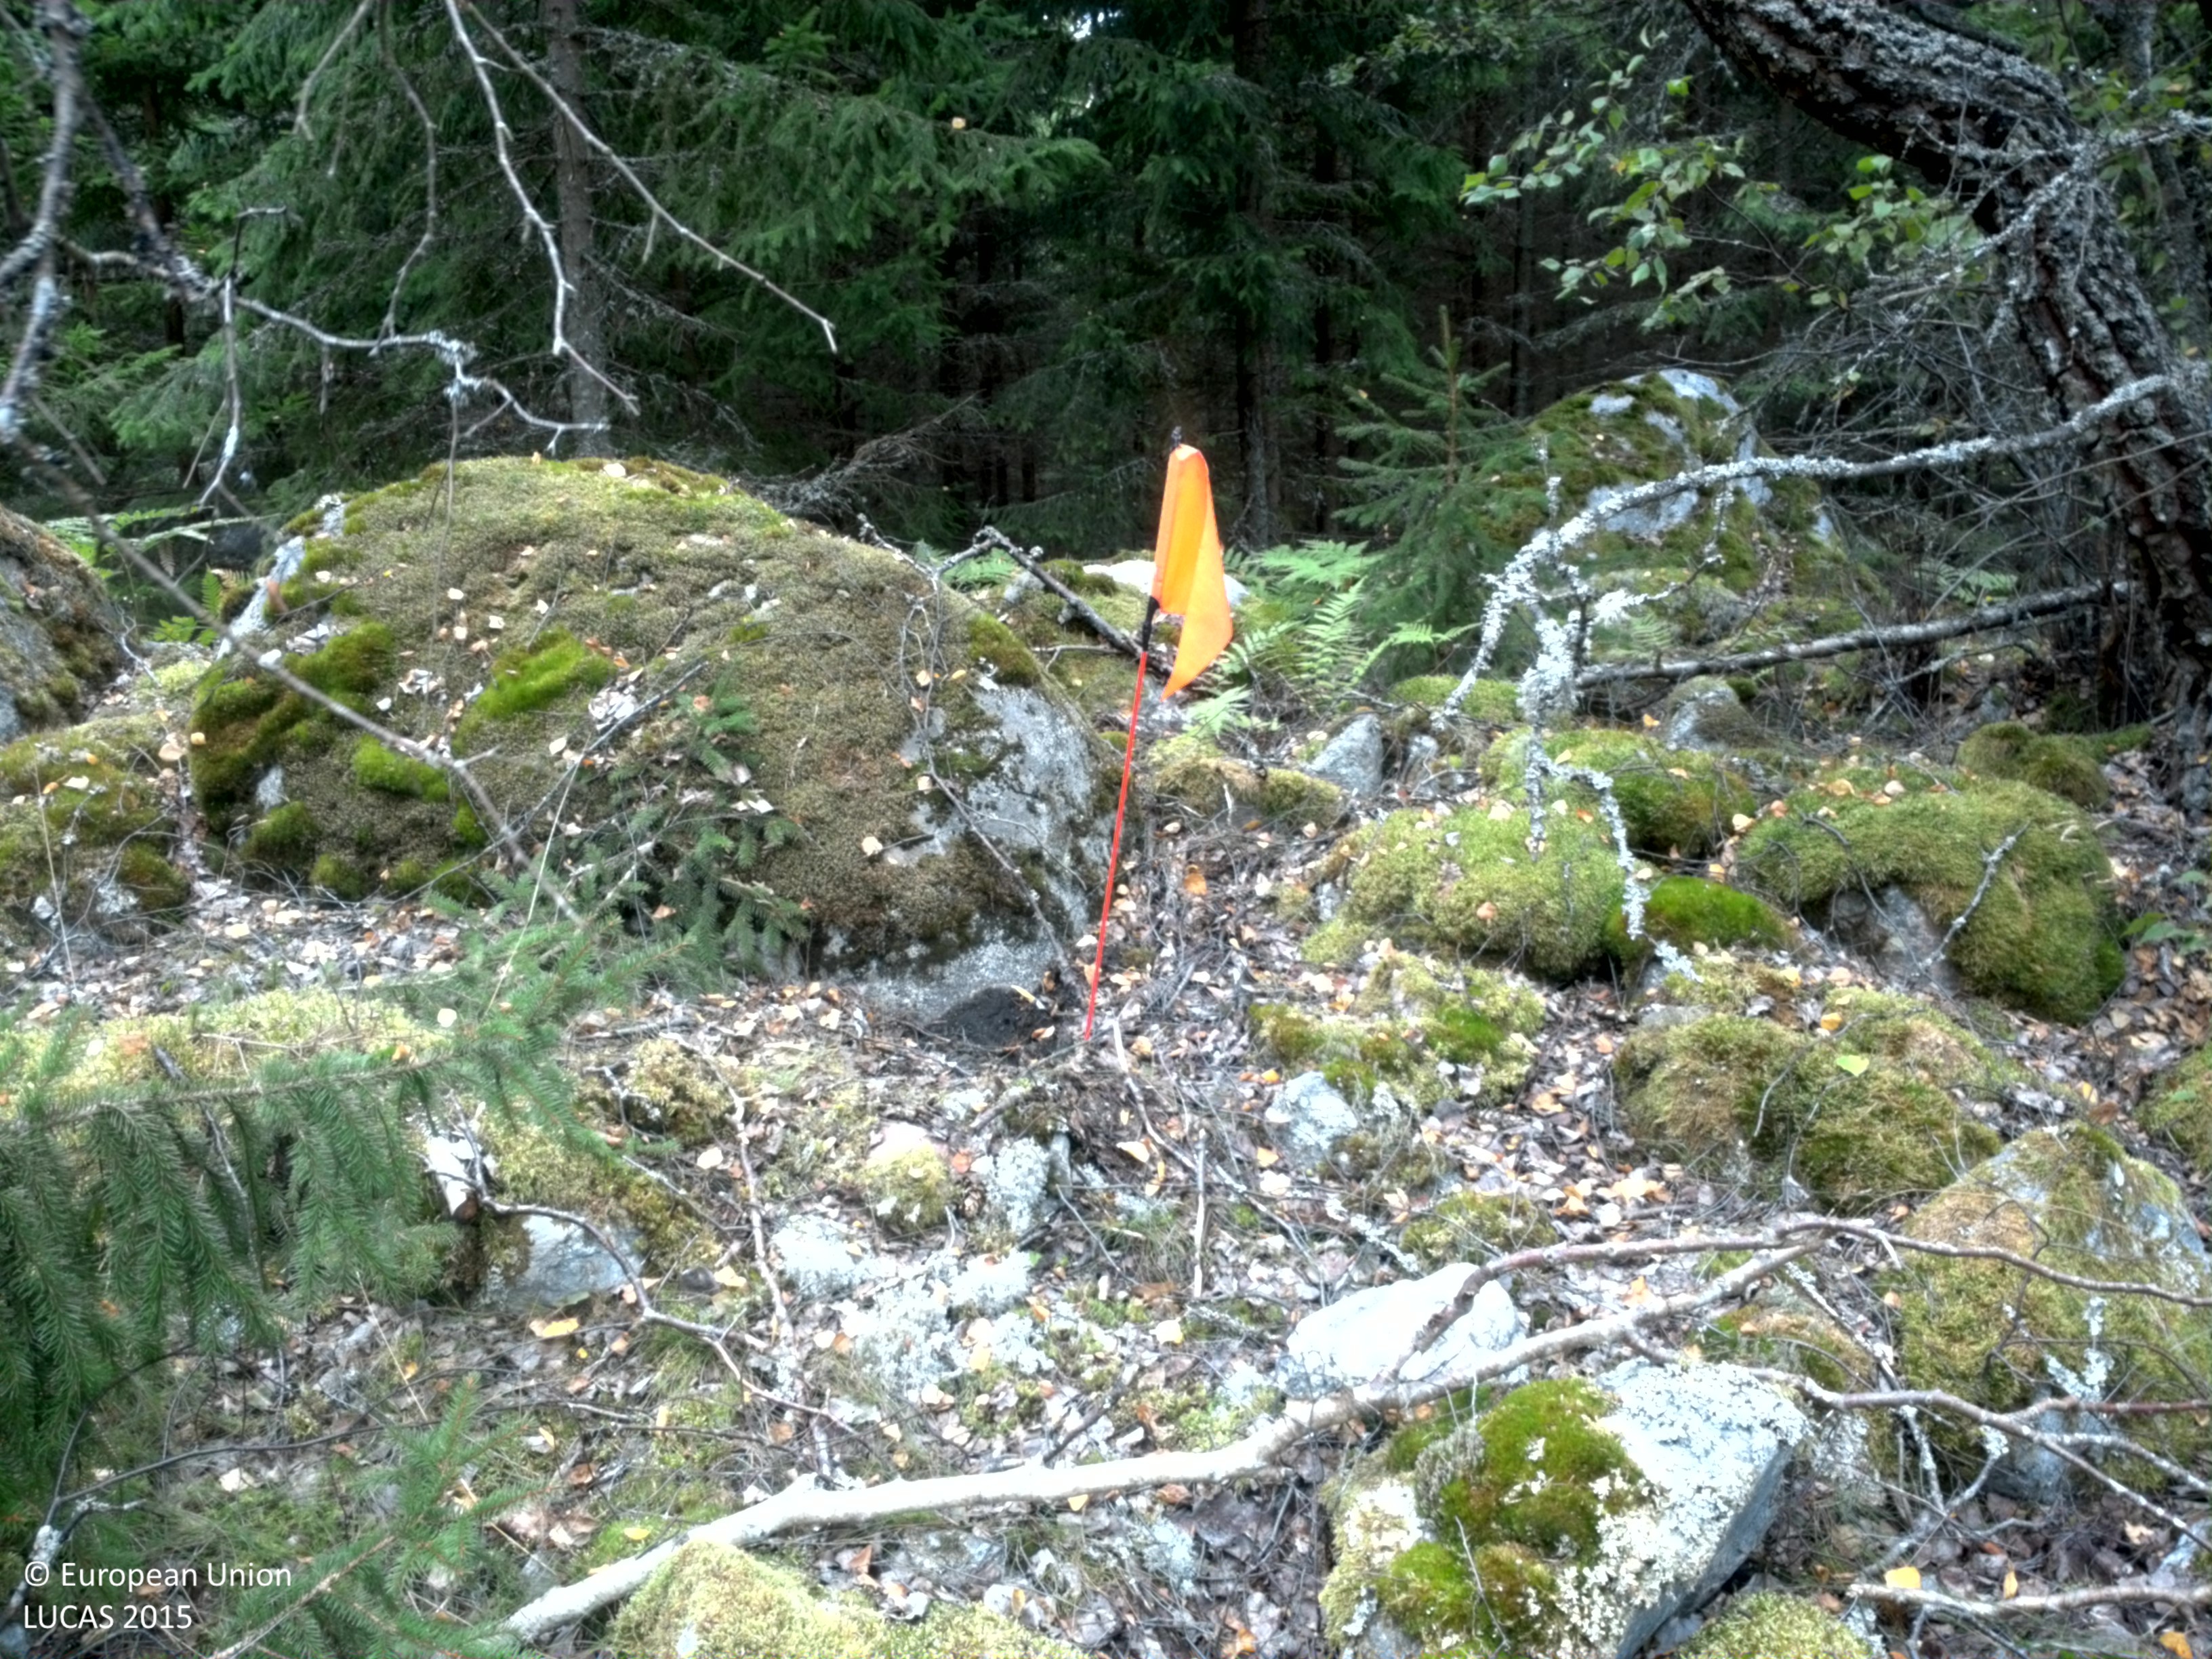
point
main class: Woodland
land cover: Spruce dominated mixed woodland
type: boreal forest
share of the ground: 50 - 75 %
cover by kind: lichens and mosses 35 %, coniferous forest trees 30 %, broadleaved forest trees 25 %, herbaceous plants 10 %
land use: Forestry
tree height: > 5 m
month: August
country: SE
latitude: 59.5271
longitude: 17.1894
